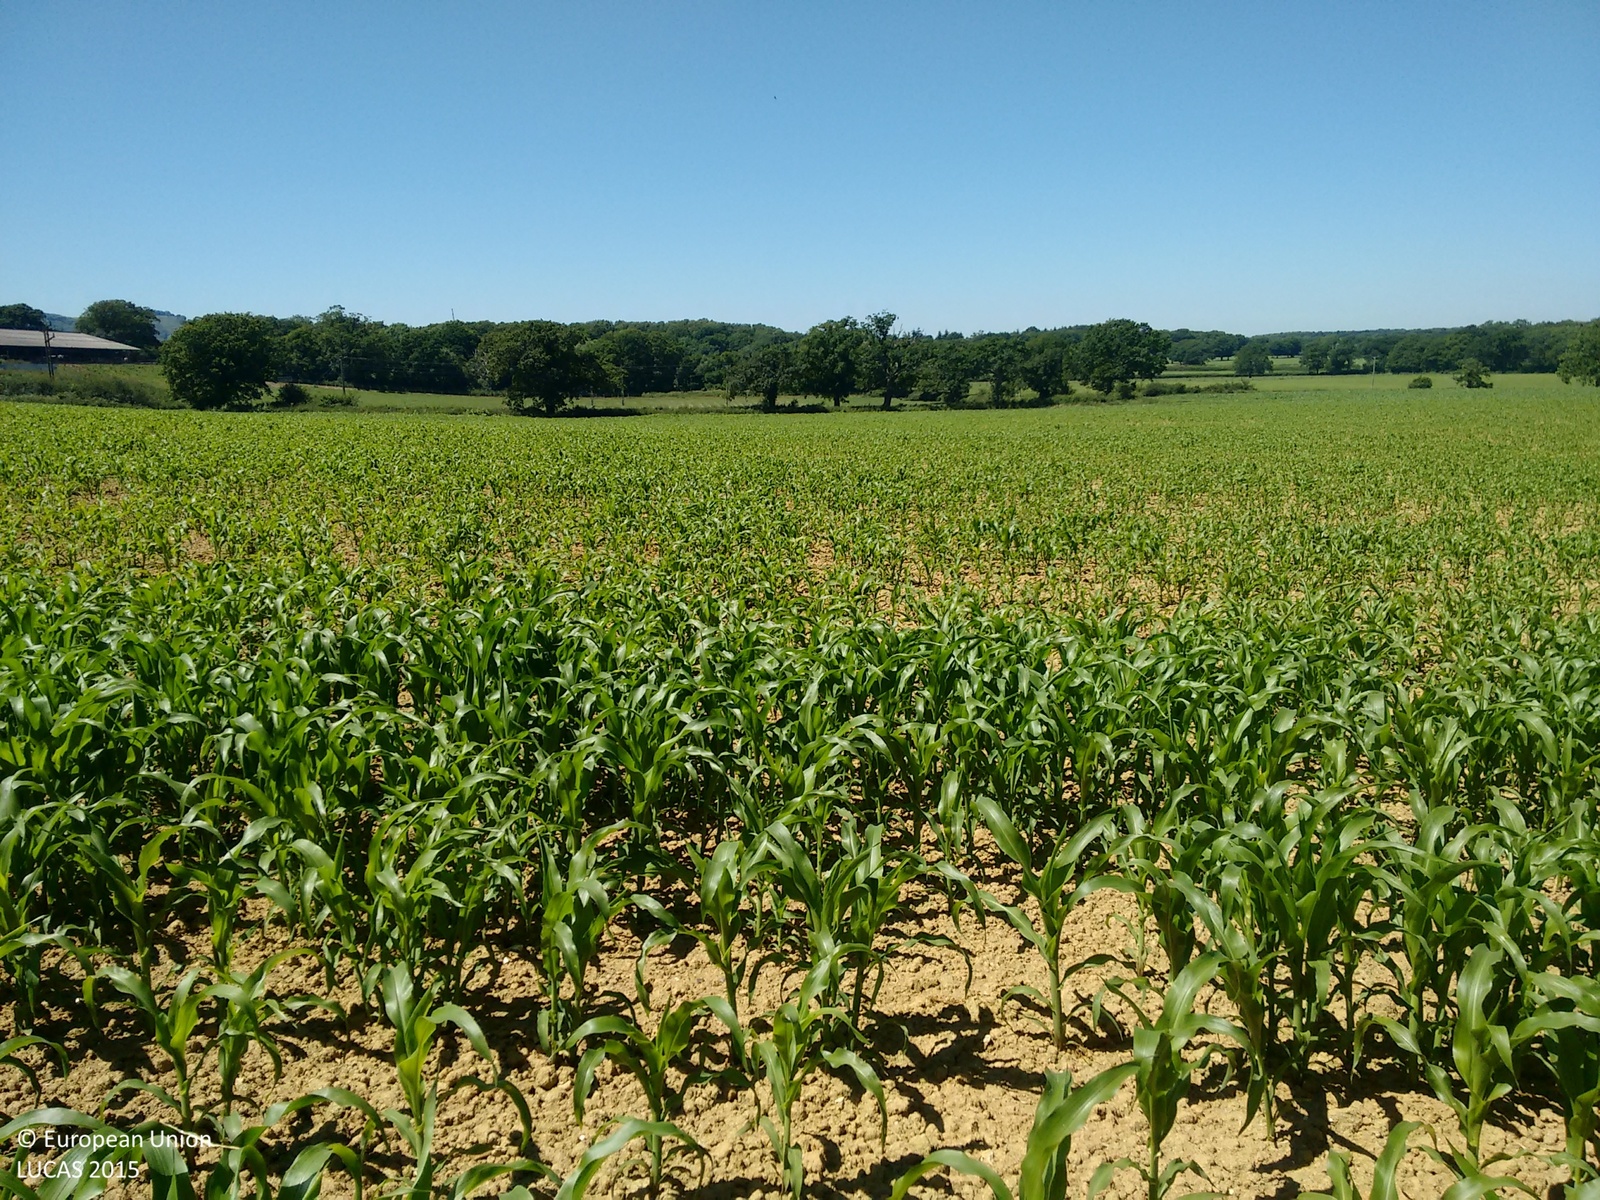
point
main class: Cropland
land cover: Maize
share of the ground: > 75 %
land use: Agriculture (excluding fallow land and kitchen gardens)
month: June
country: GB
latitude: 50.9113
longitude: -0.3191
